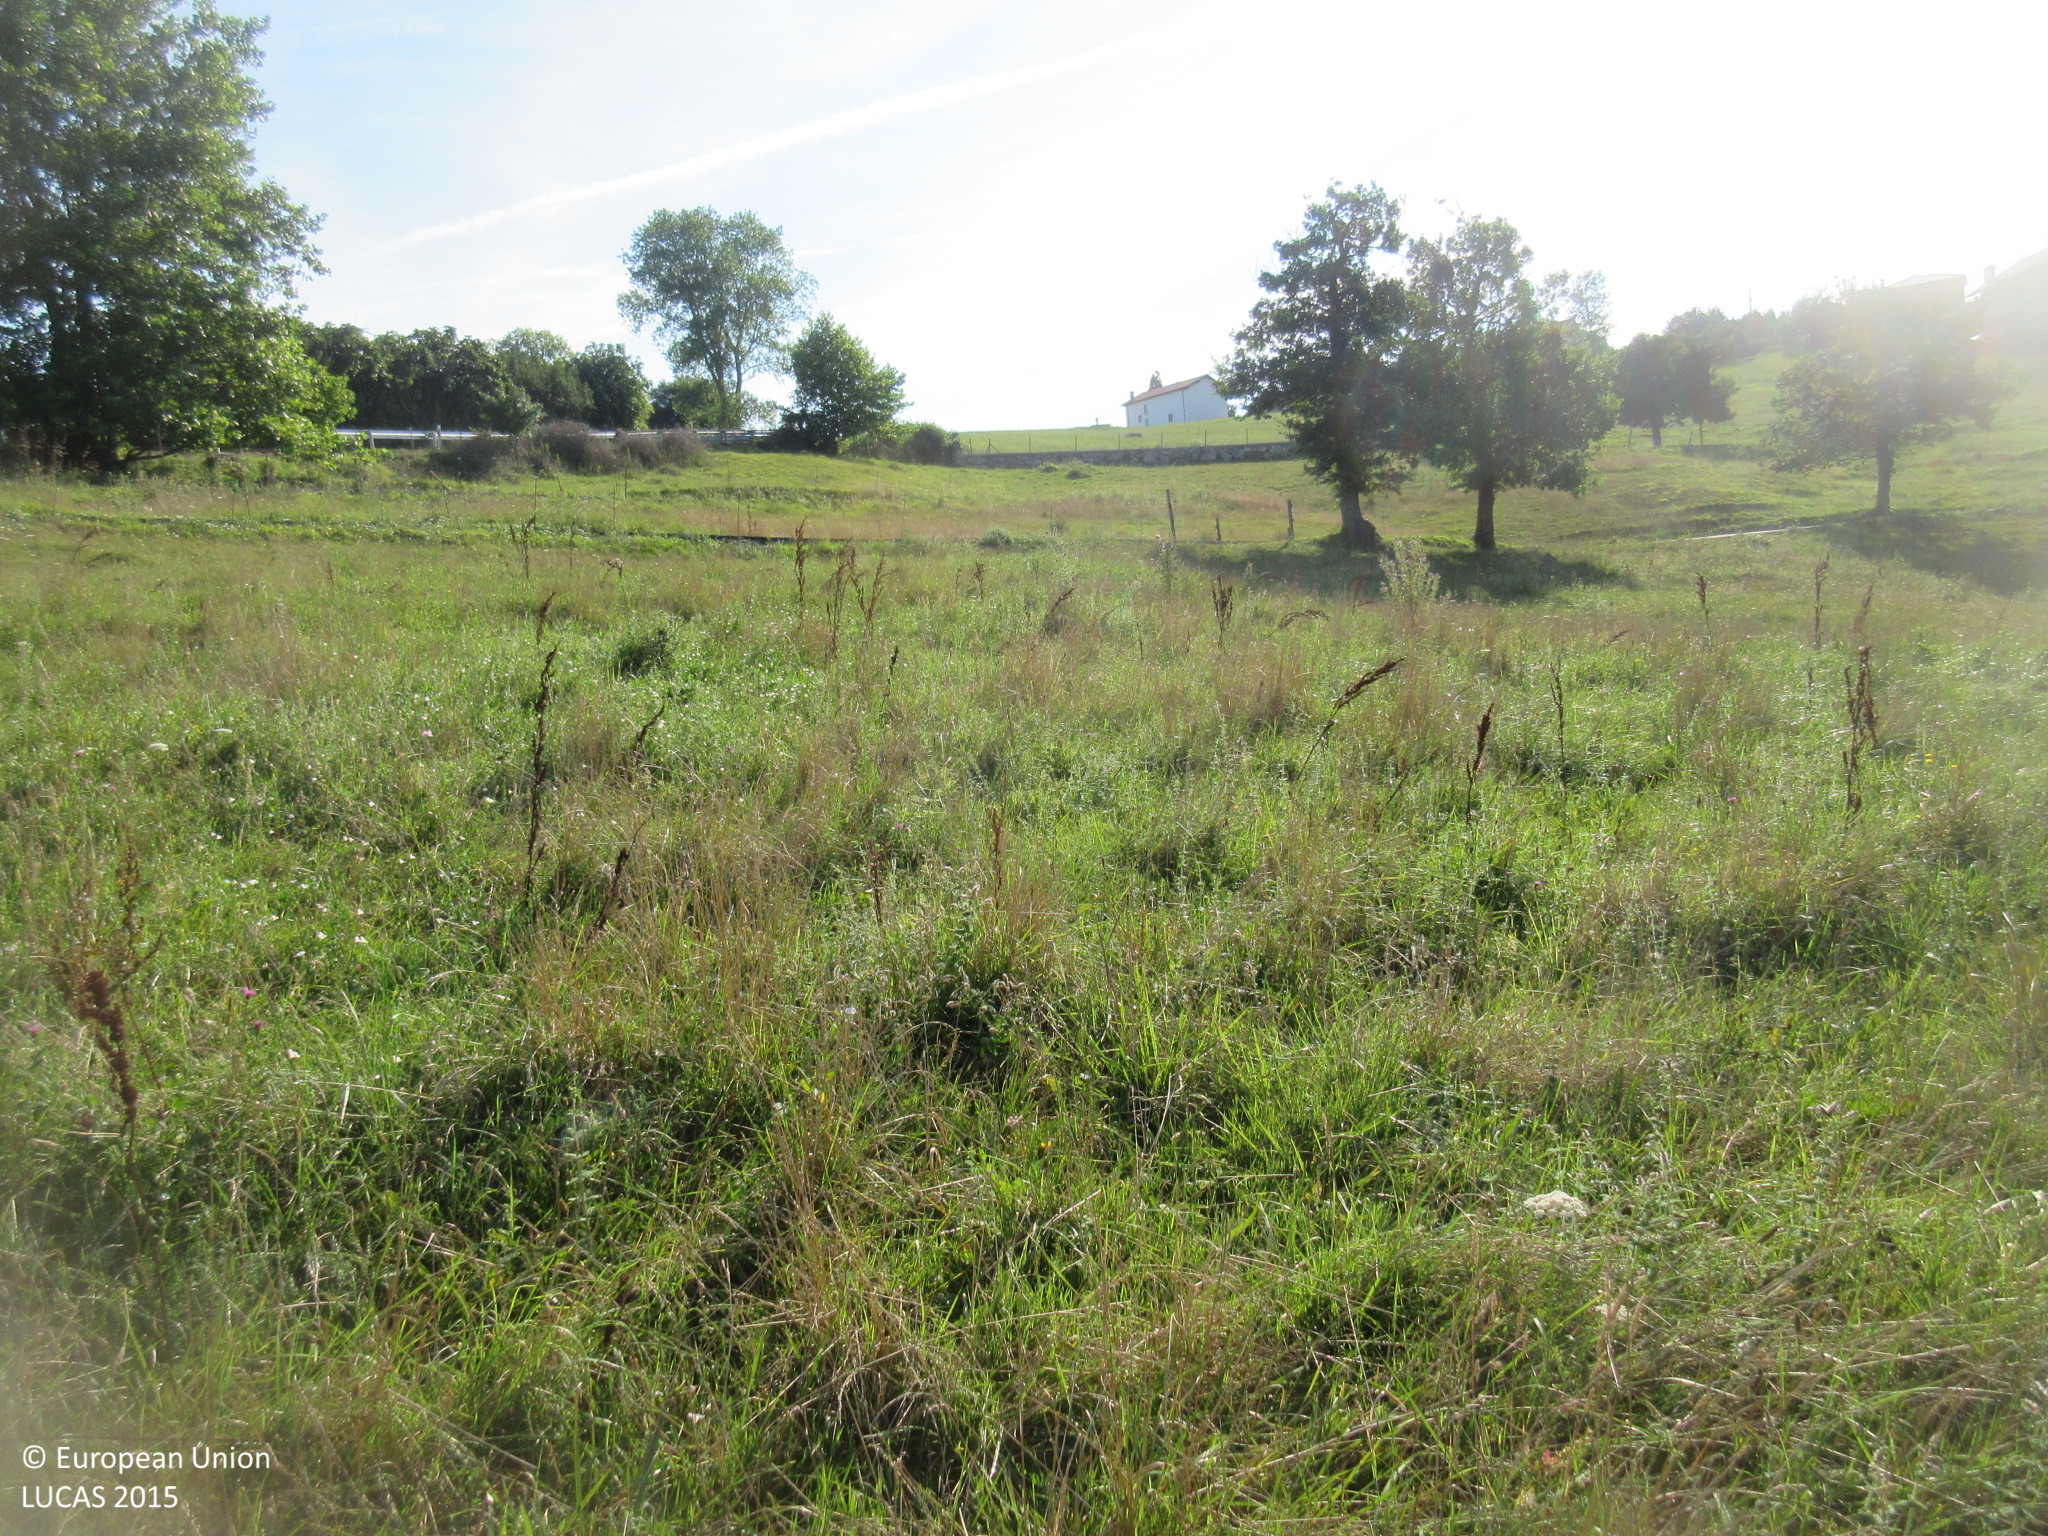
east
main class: Grassland
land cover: Grassland without tree/shrub cover
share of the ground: > 75 %
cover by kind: herbaceous plants 100 %
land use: Agriculture (excluding fallow land and kitchen gardens)
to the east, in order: Grassland without tree/shrub cover; Tracks; Grassland without tree/shrub cover; Electric lines; Grassland without tree/shrub cover; Electric lines; Grassland without tree/shrub cover; Tracks; Single bushes/trees; Grassland without tree/shrub cover; Groves; Electric lines; Grassland without tree/shrub cover; Artificial constructions in urban areas
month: July
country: ES
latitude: 43.3973
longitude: -3.9909
